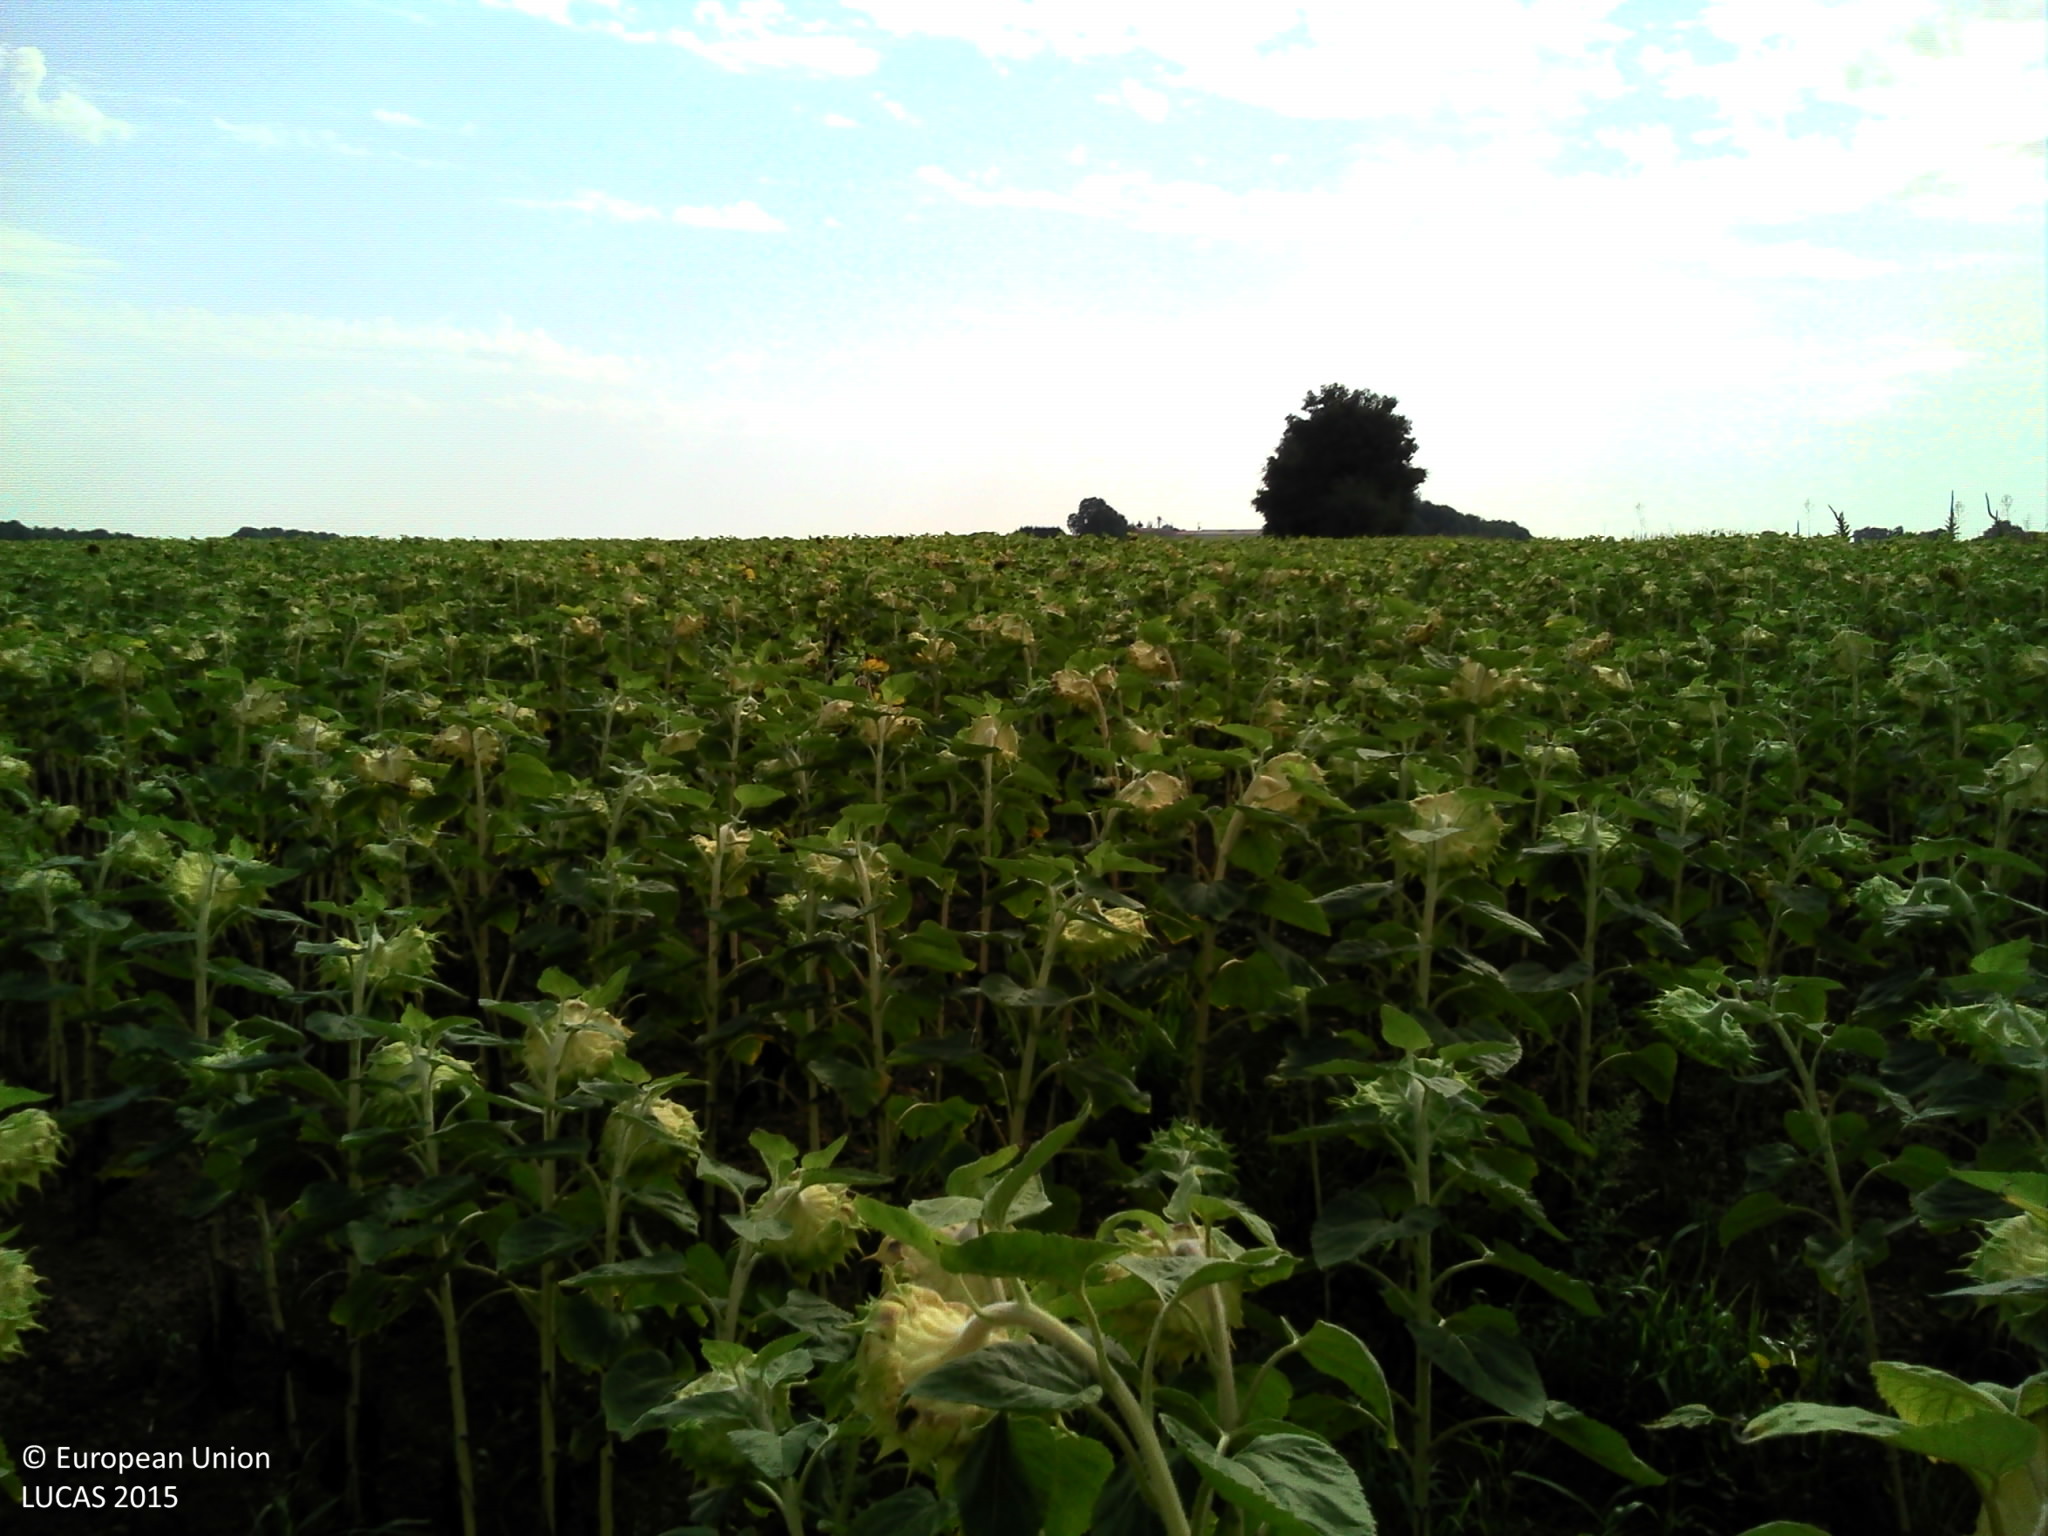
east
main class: Cropland
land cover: Sunflower
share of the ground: > 75 %
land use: Agriculture (excluding fallow land and kitchen gardens)
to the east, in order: Sunflower
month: August
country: FR
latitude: 46.1865
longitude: 0.3564
